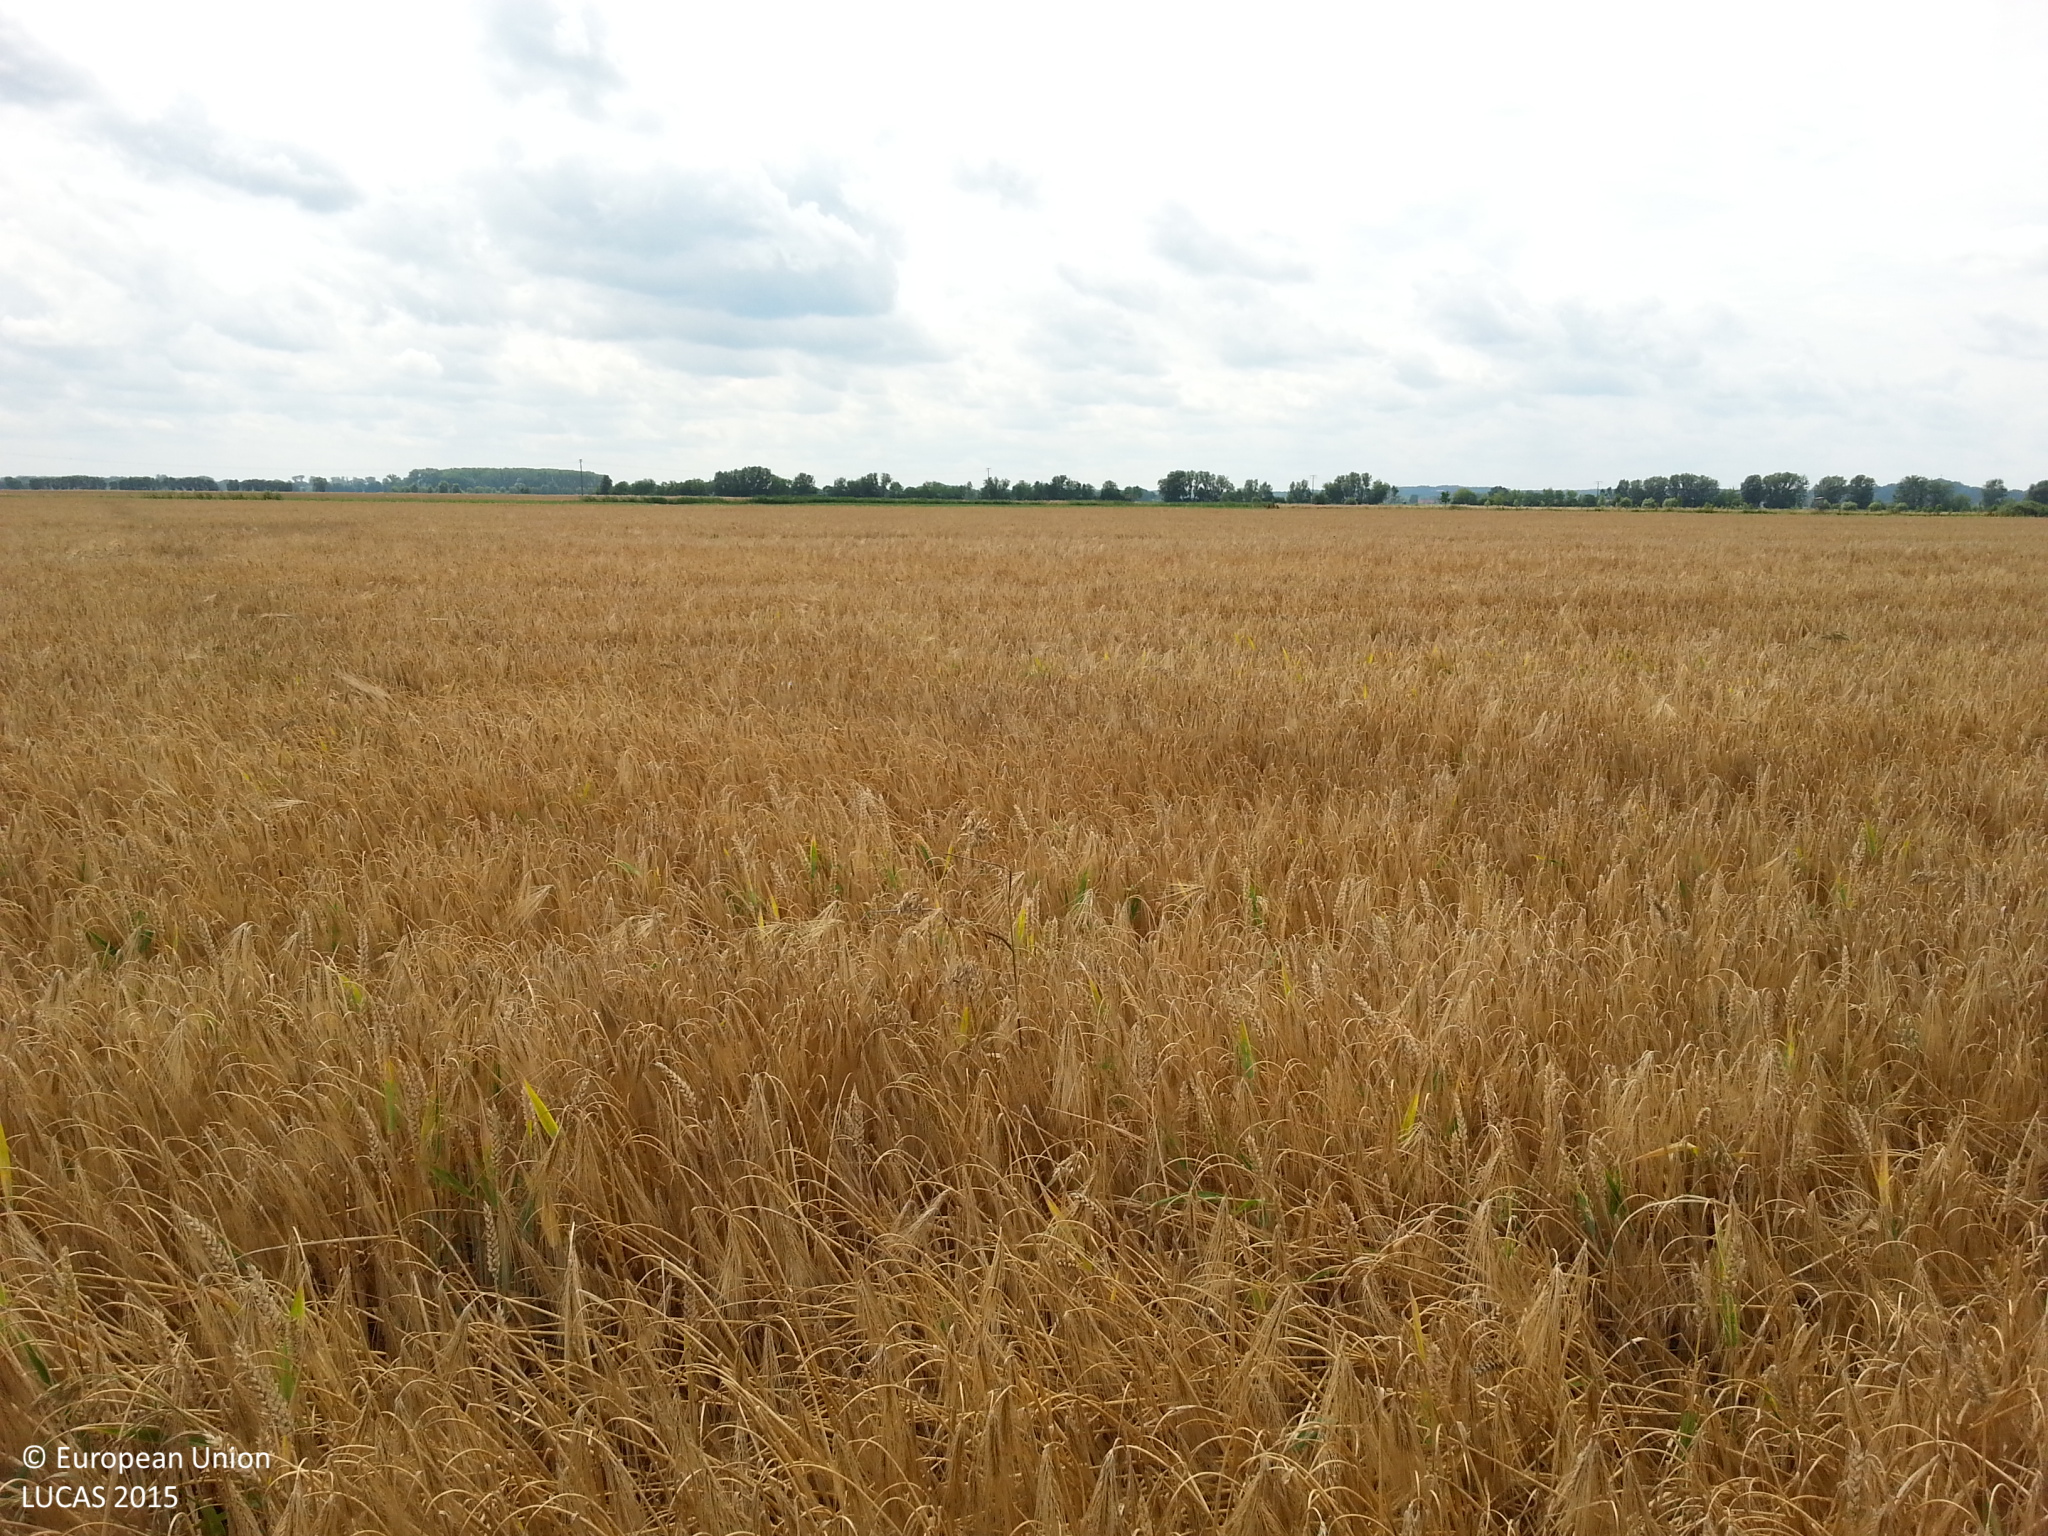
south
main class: Cropland
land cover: Barley
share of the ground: > 75 %
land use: Agriculture (excluding fallow land and kitchen gardens)
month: July
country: DE
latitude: 53.1813
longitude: 11.0919
